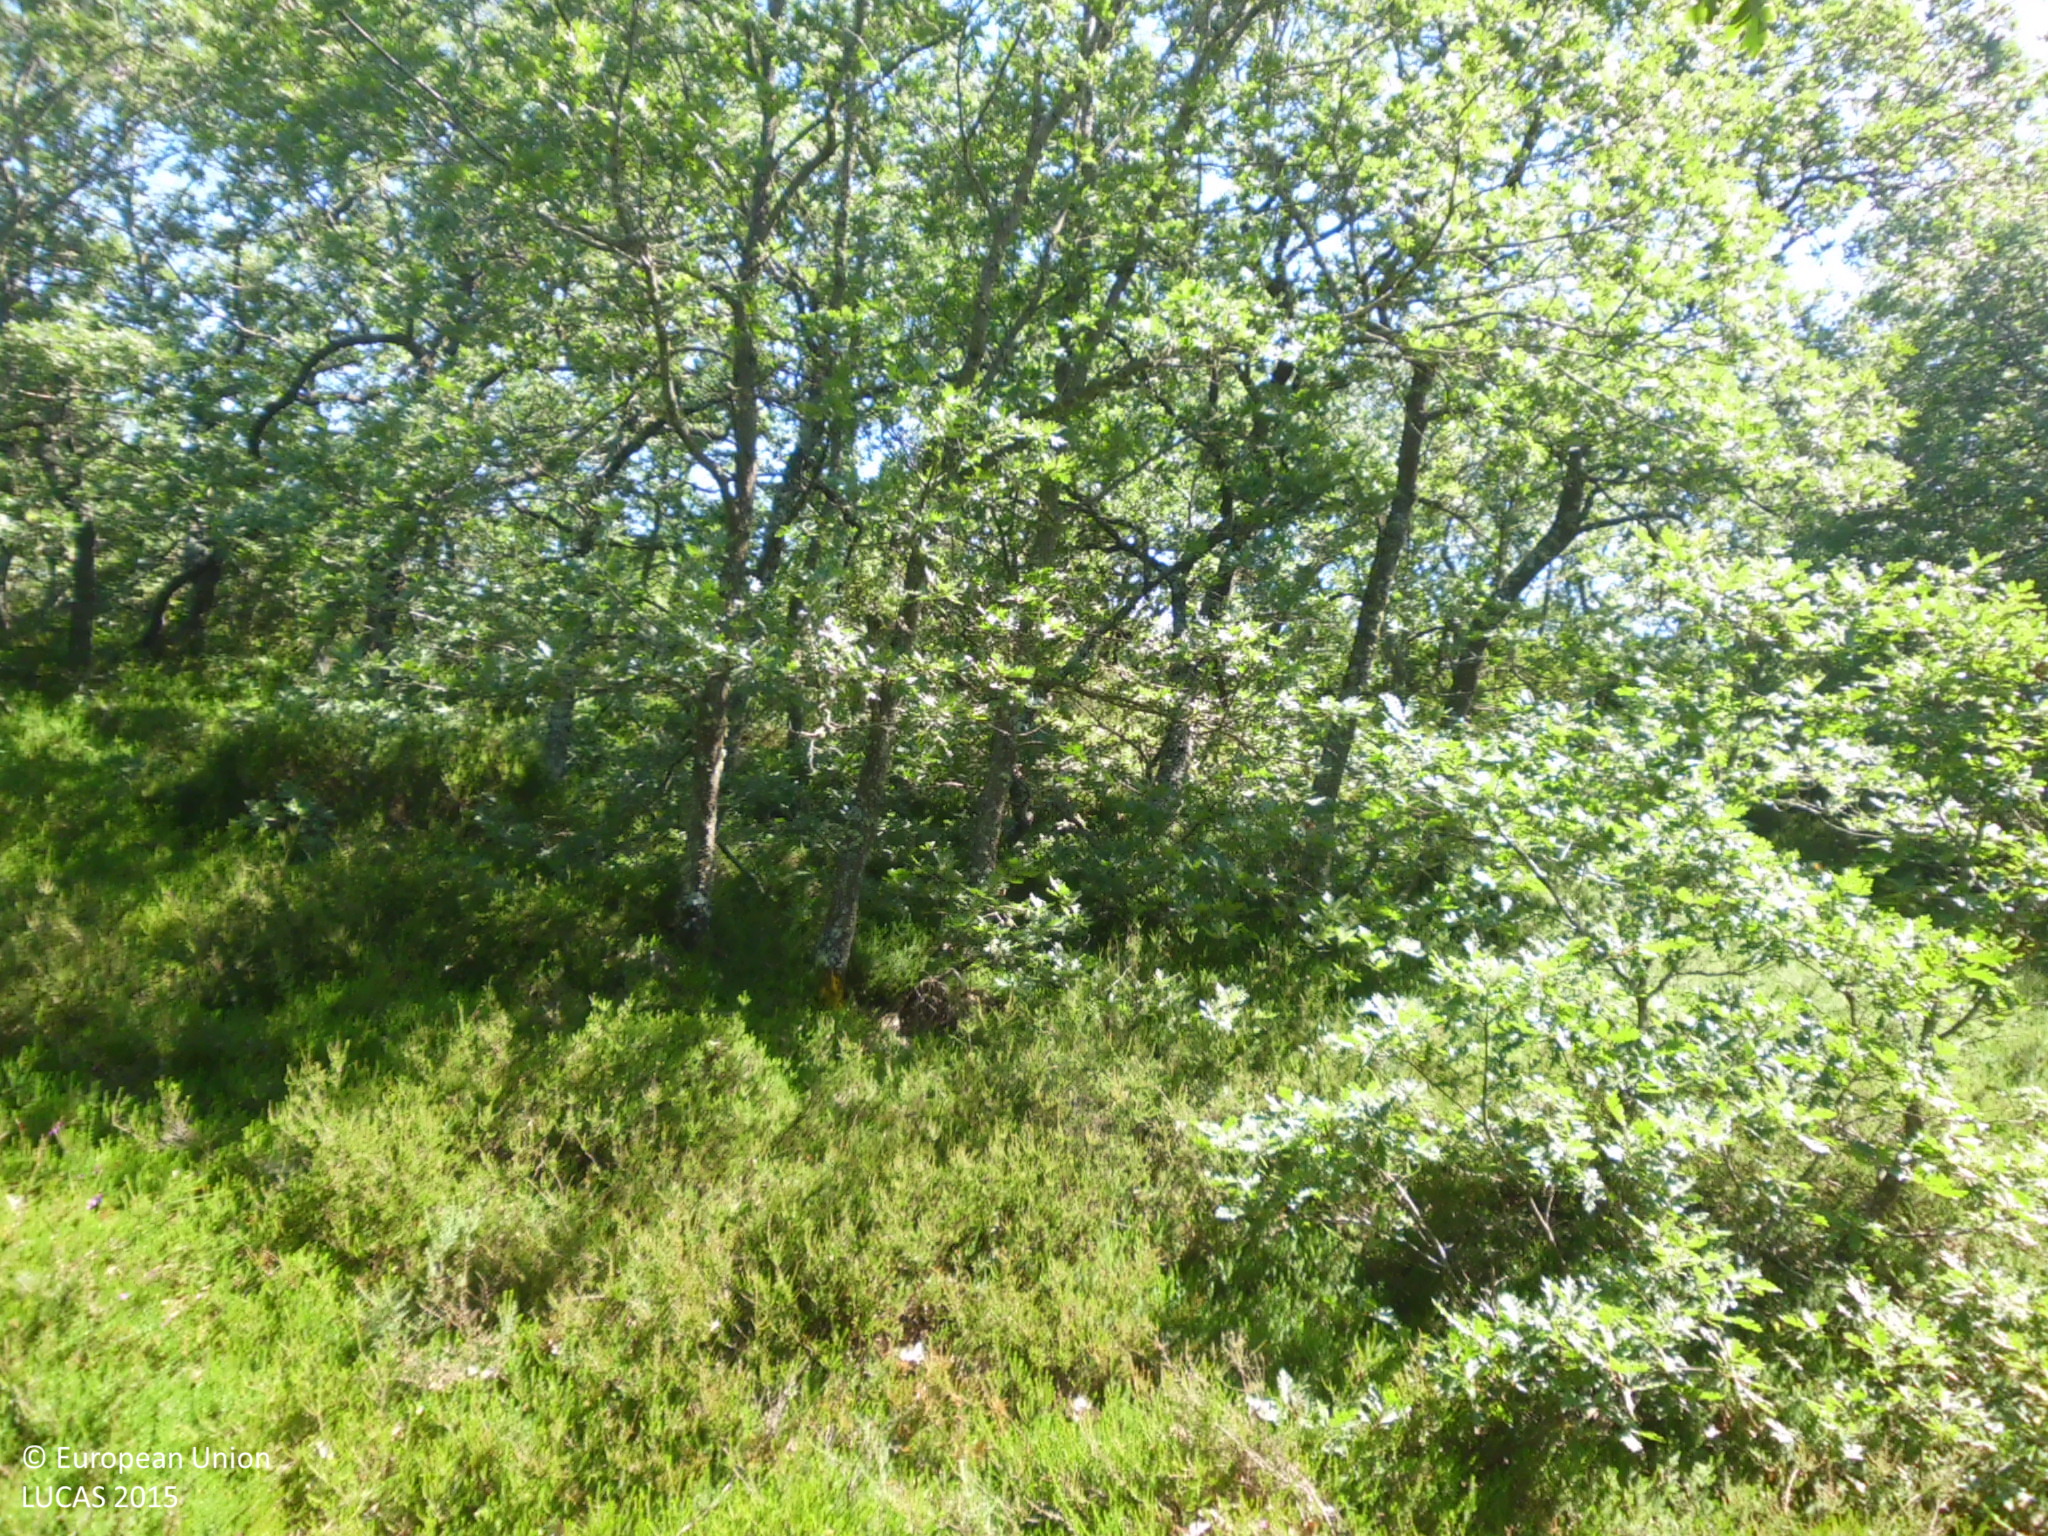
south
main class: Woodland
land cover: Broadleaved woodland
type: acidophilous oak and oak-birch forest
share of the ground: 25 - 50 %
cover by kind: broadleaved forest trees 40 %, shrubs 40 %, consolidated bare surface 15 %, herbaceous plants 5 %
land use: Semi-natural and natural areas not in use
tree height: > 5 m
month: June
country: ES
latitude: 42.6237
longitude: -4.0293
